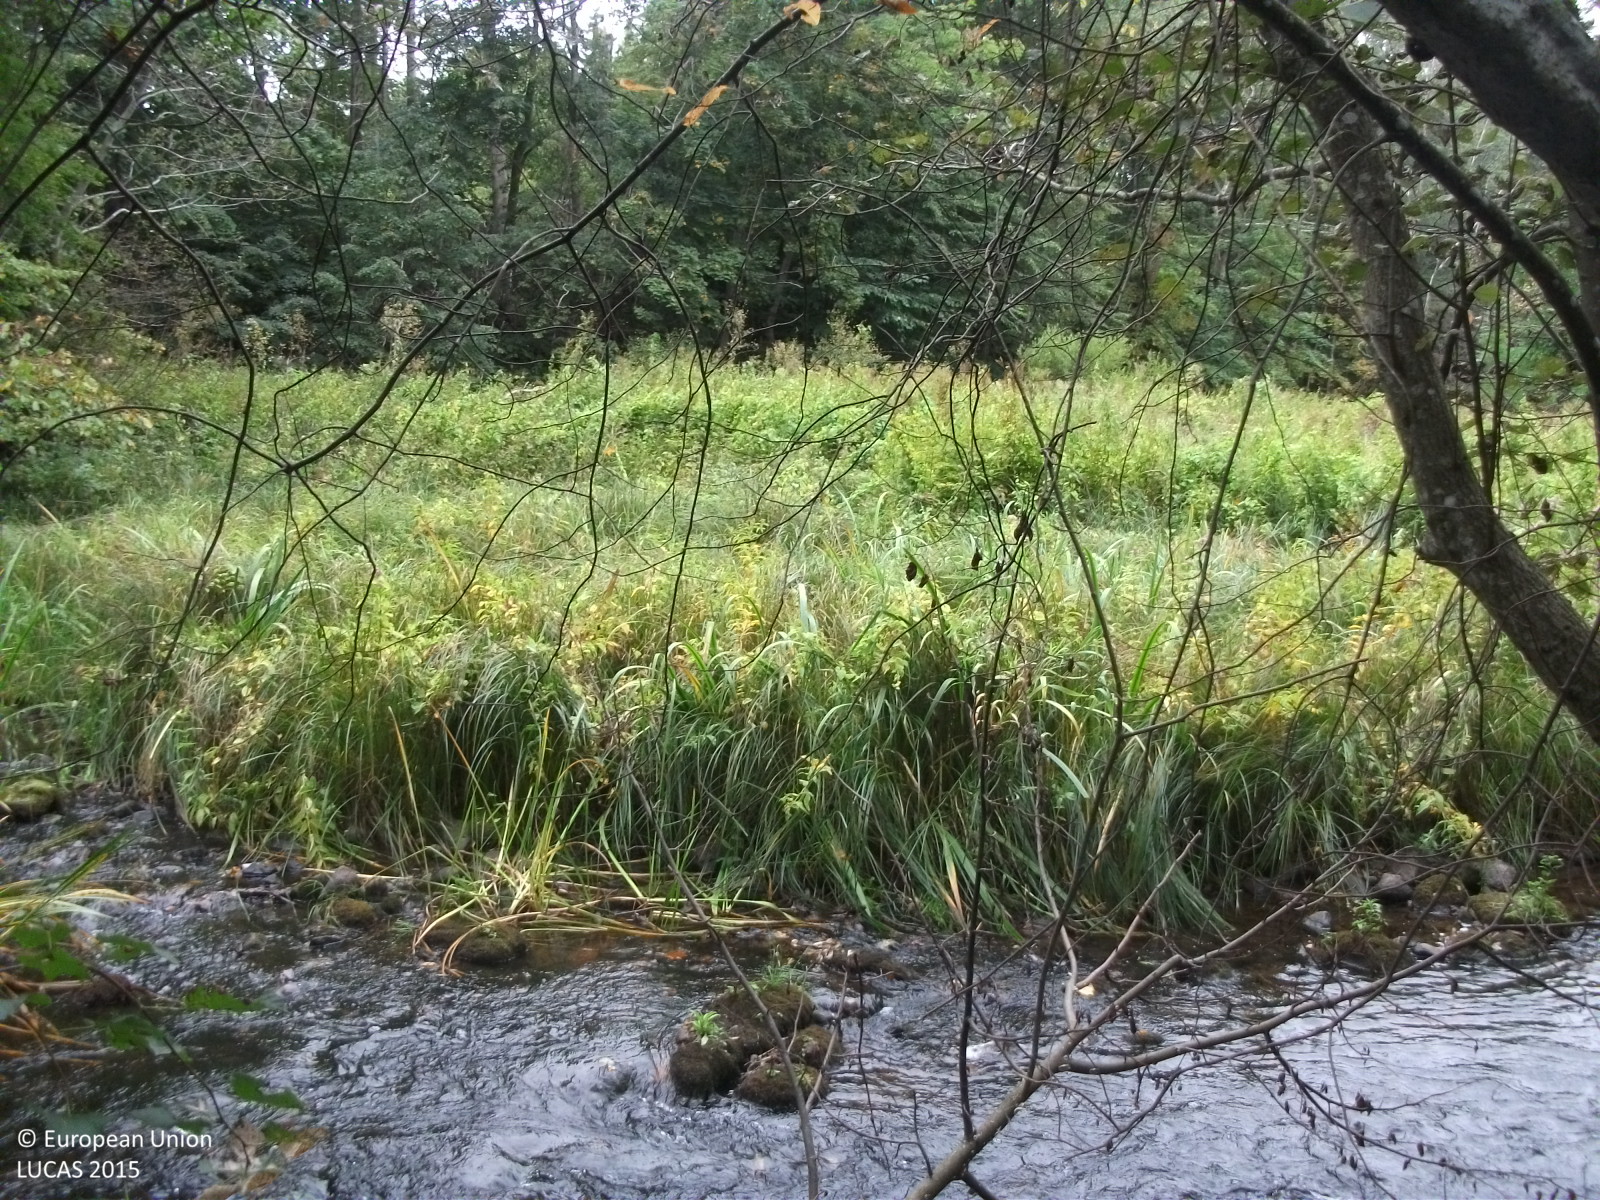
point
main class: Grassland
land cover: Spontaneously vegetated surfaces
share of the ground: > 75 %
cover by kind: herbaceous plants 100 %
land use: Semi-natural and natural areas not in use
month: September
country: LV
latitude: 57.6525
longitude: 24.4500
